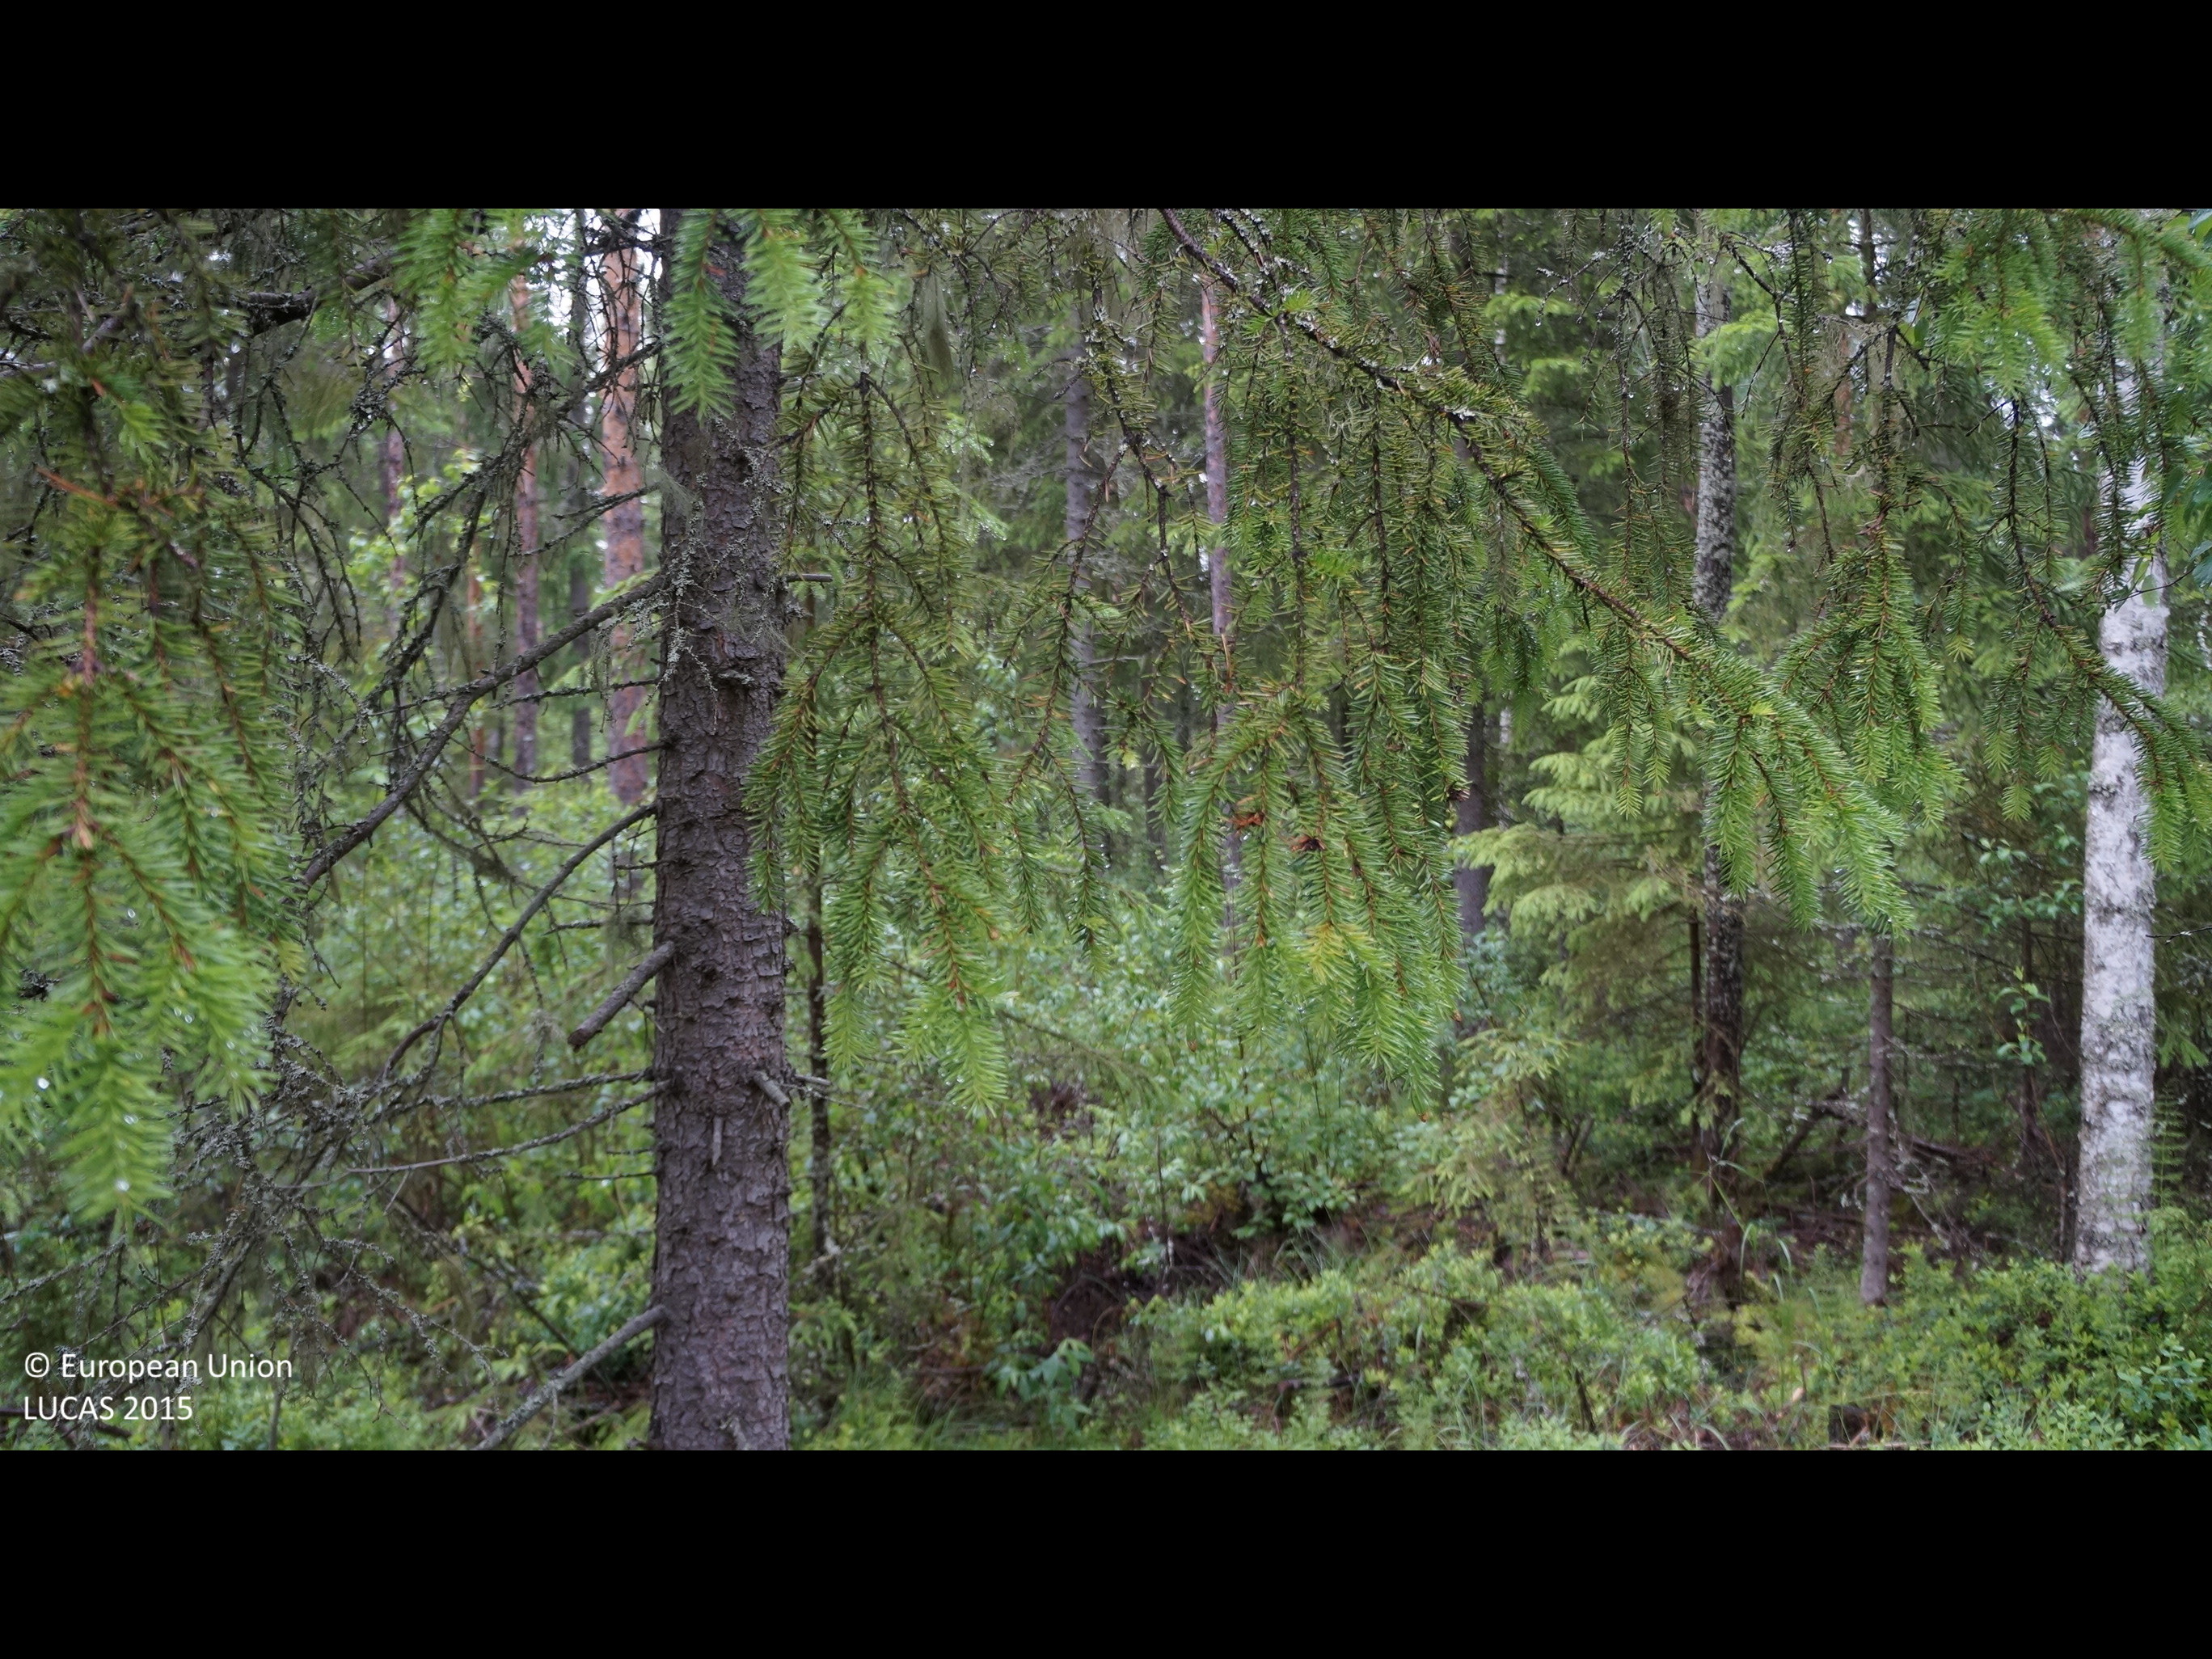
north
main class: Woodland
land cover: Spruce dominated coniferous woodland
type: boreal forest
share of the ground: 50 - 75 %
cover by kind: coniferous forest trees 60 %, shrubs 30 %, broadleaved forest trees 5 %, herbaceous plants 5 %
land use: Forestry
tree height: > 5 m
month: June
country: FI
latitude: 64.3323
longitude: 24.5353
